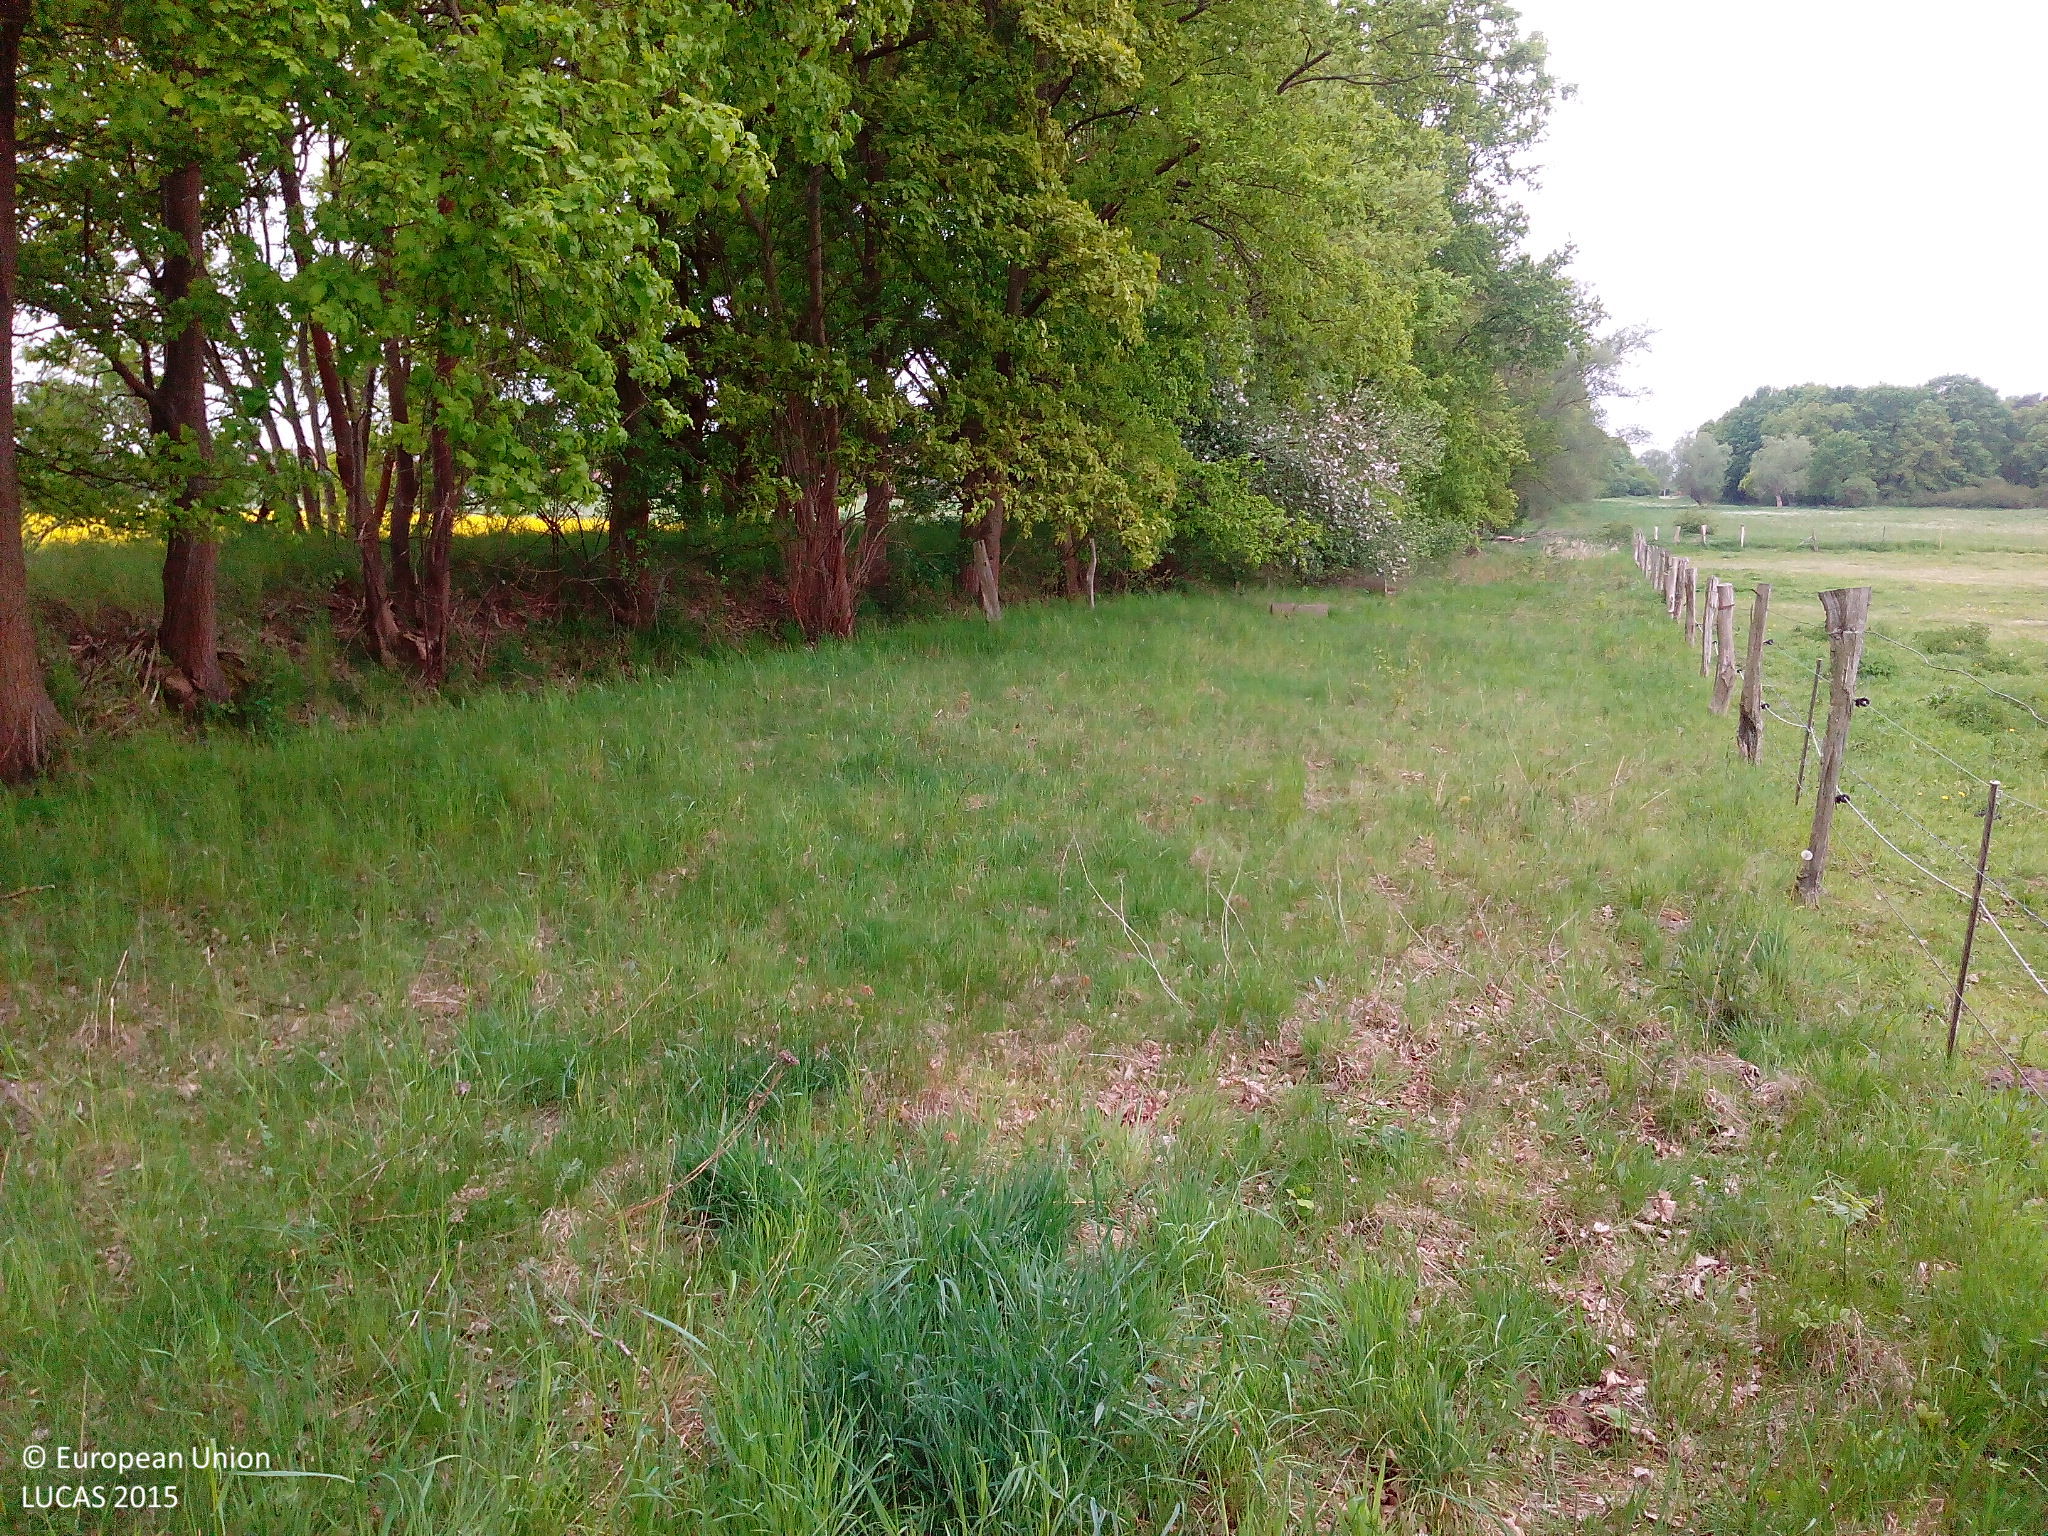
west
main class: Woodland
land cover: Broadleaved woodland
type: mesophytic deciduous forest
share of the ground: 10 - 25 %
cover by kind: herbaceous plants 80 %, broadleaved forest trees 20 %
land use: Agriculture (excluding fallow land and kitchen gardens)
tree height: > 5 m
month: May
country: DE
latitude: 52.8159
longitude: 11.6168
